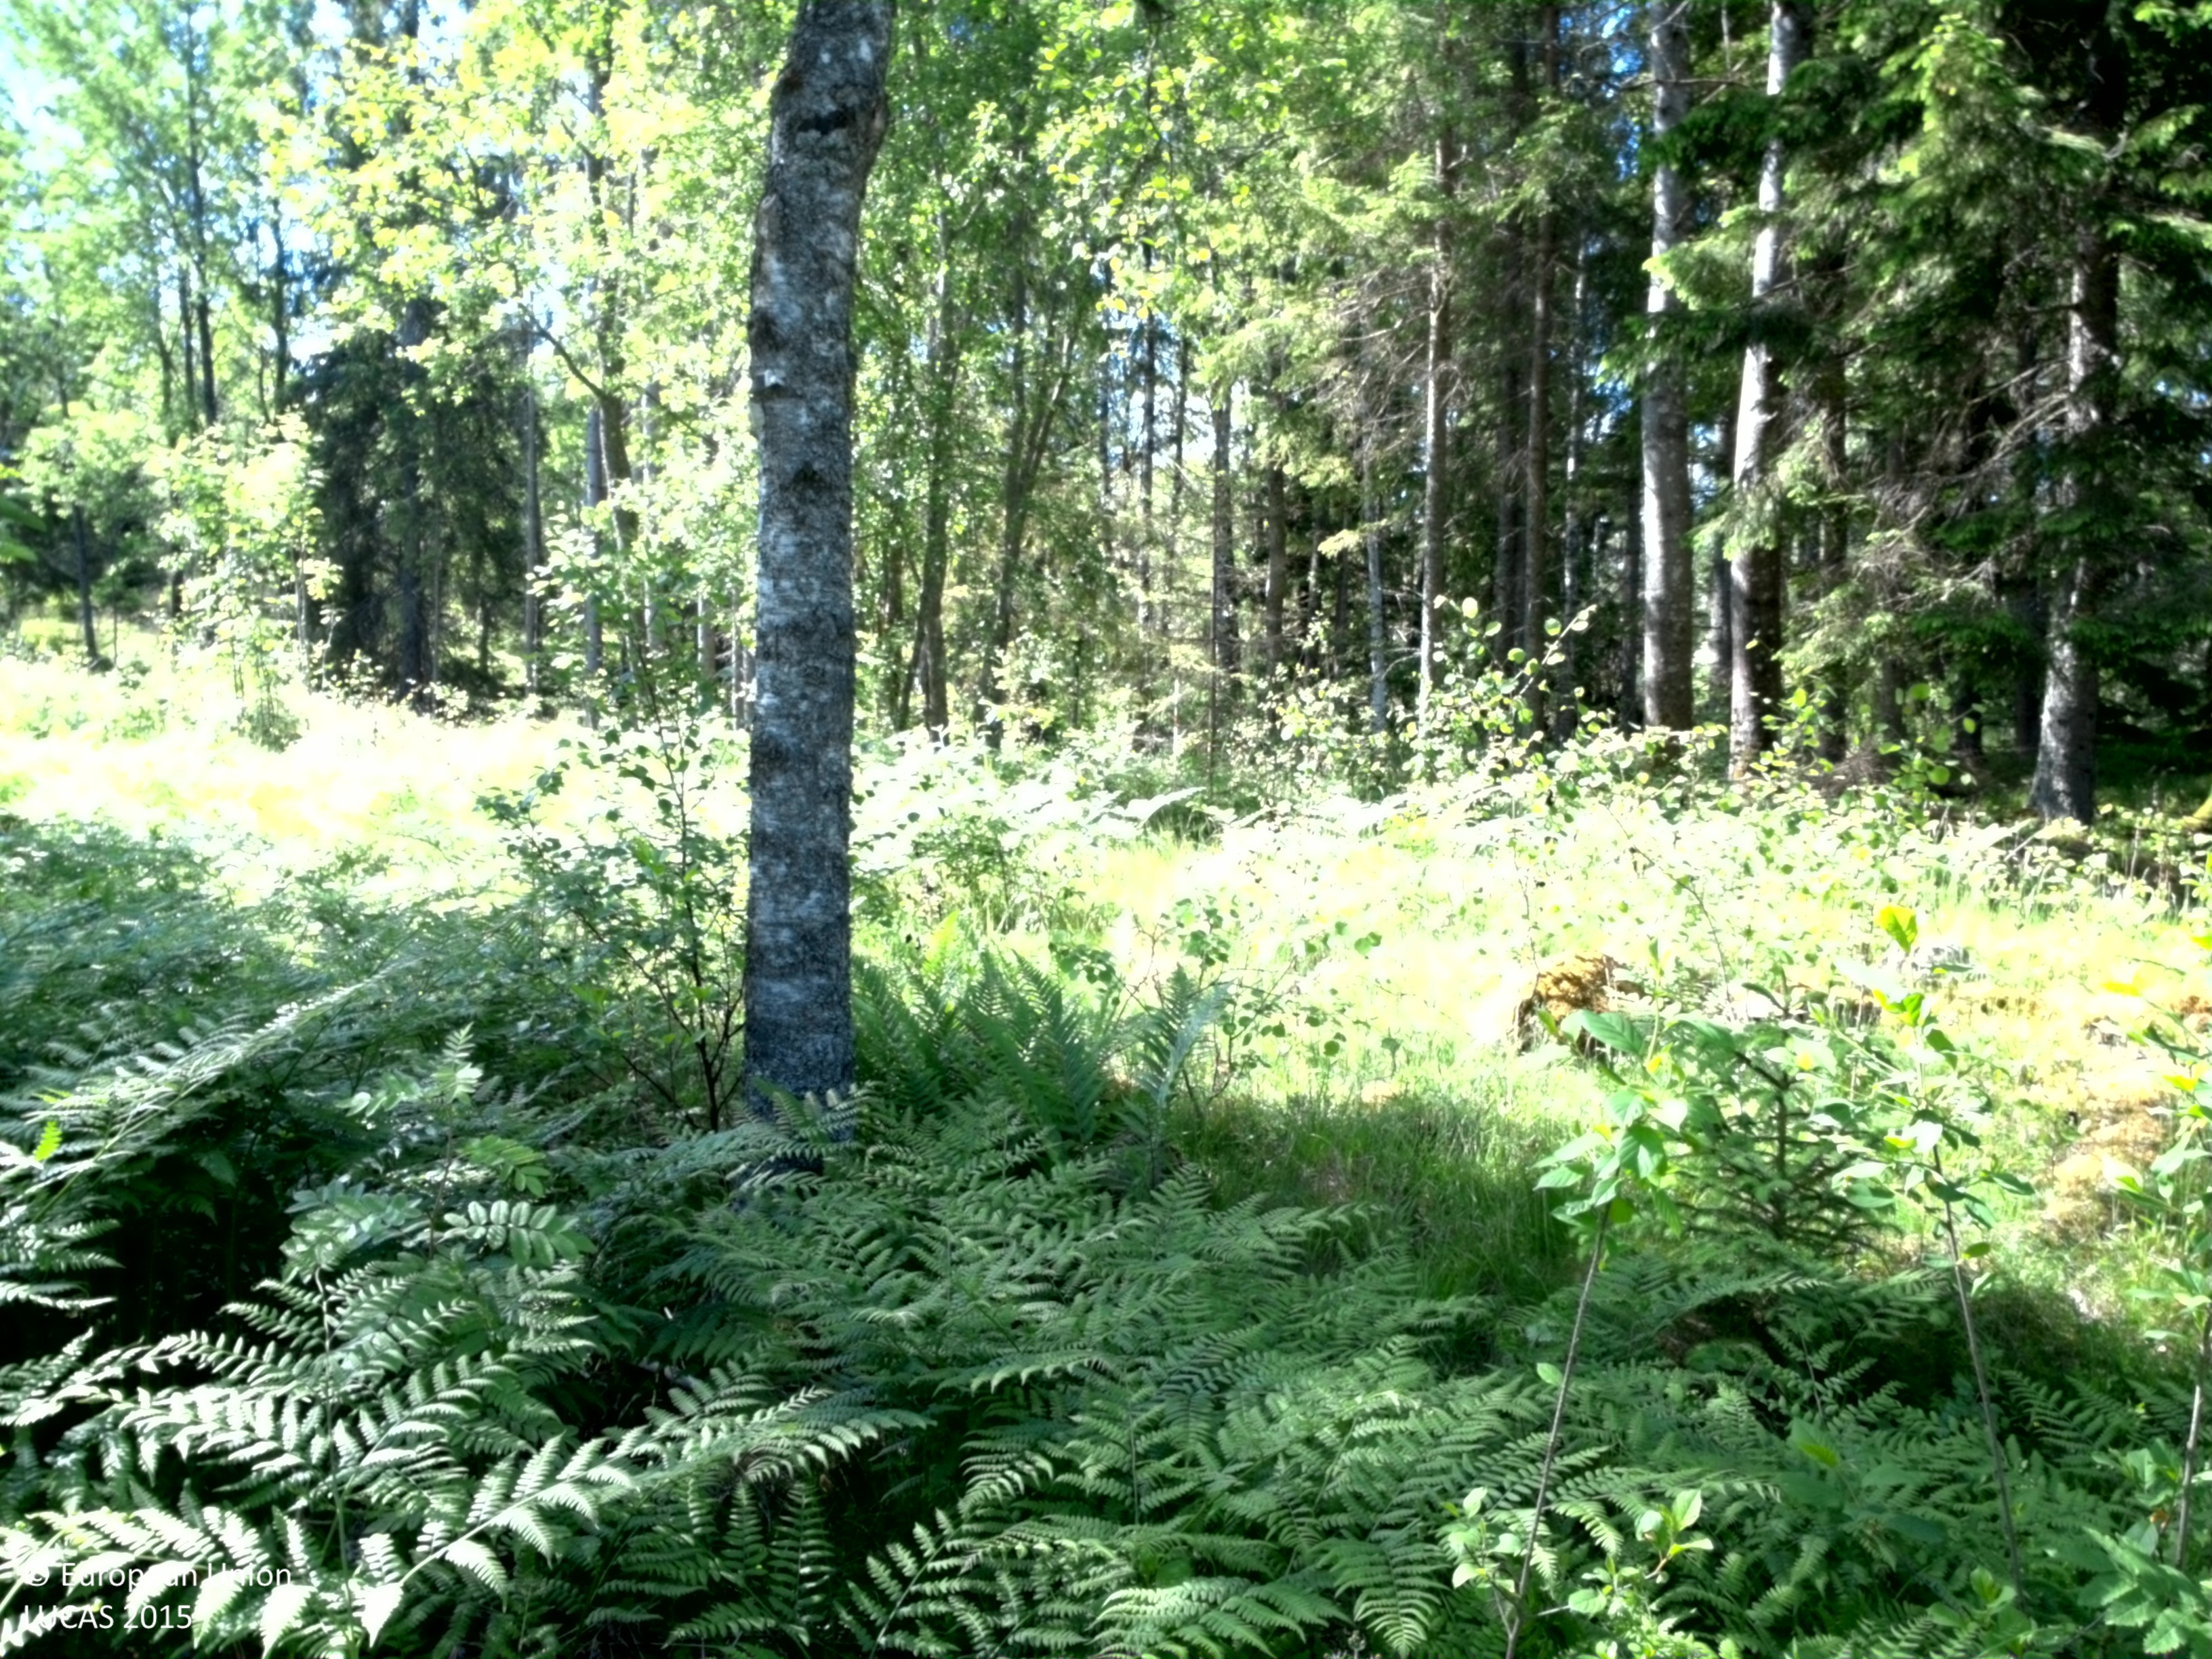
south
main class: Woodland
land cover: Broadleaved woodland
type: boreal forest
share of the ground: 25 - 50 %
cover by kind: herbaceous plants 50 %, broadleaved forest trees 25 %, shrubs 20 %, coniferous forest trees 5 %
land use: Forestry
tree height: > 5 m
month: June
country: SE
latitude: 58.6176
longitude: 14.3491
